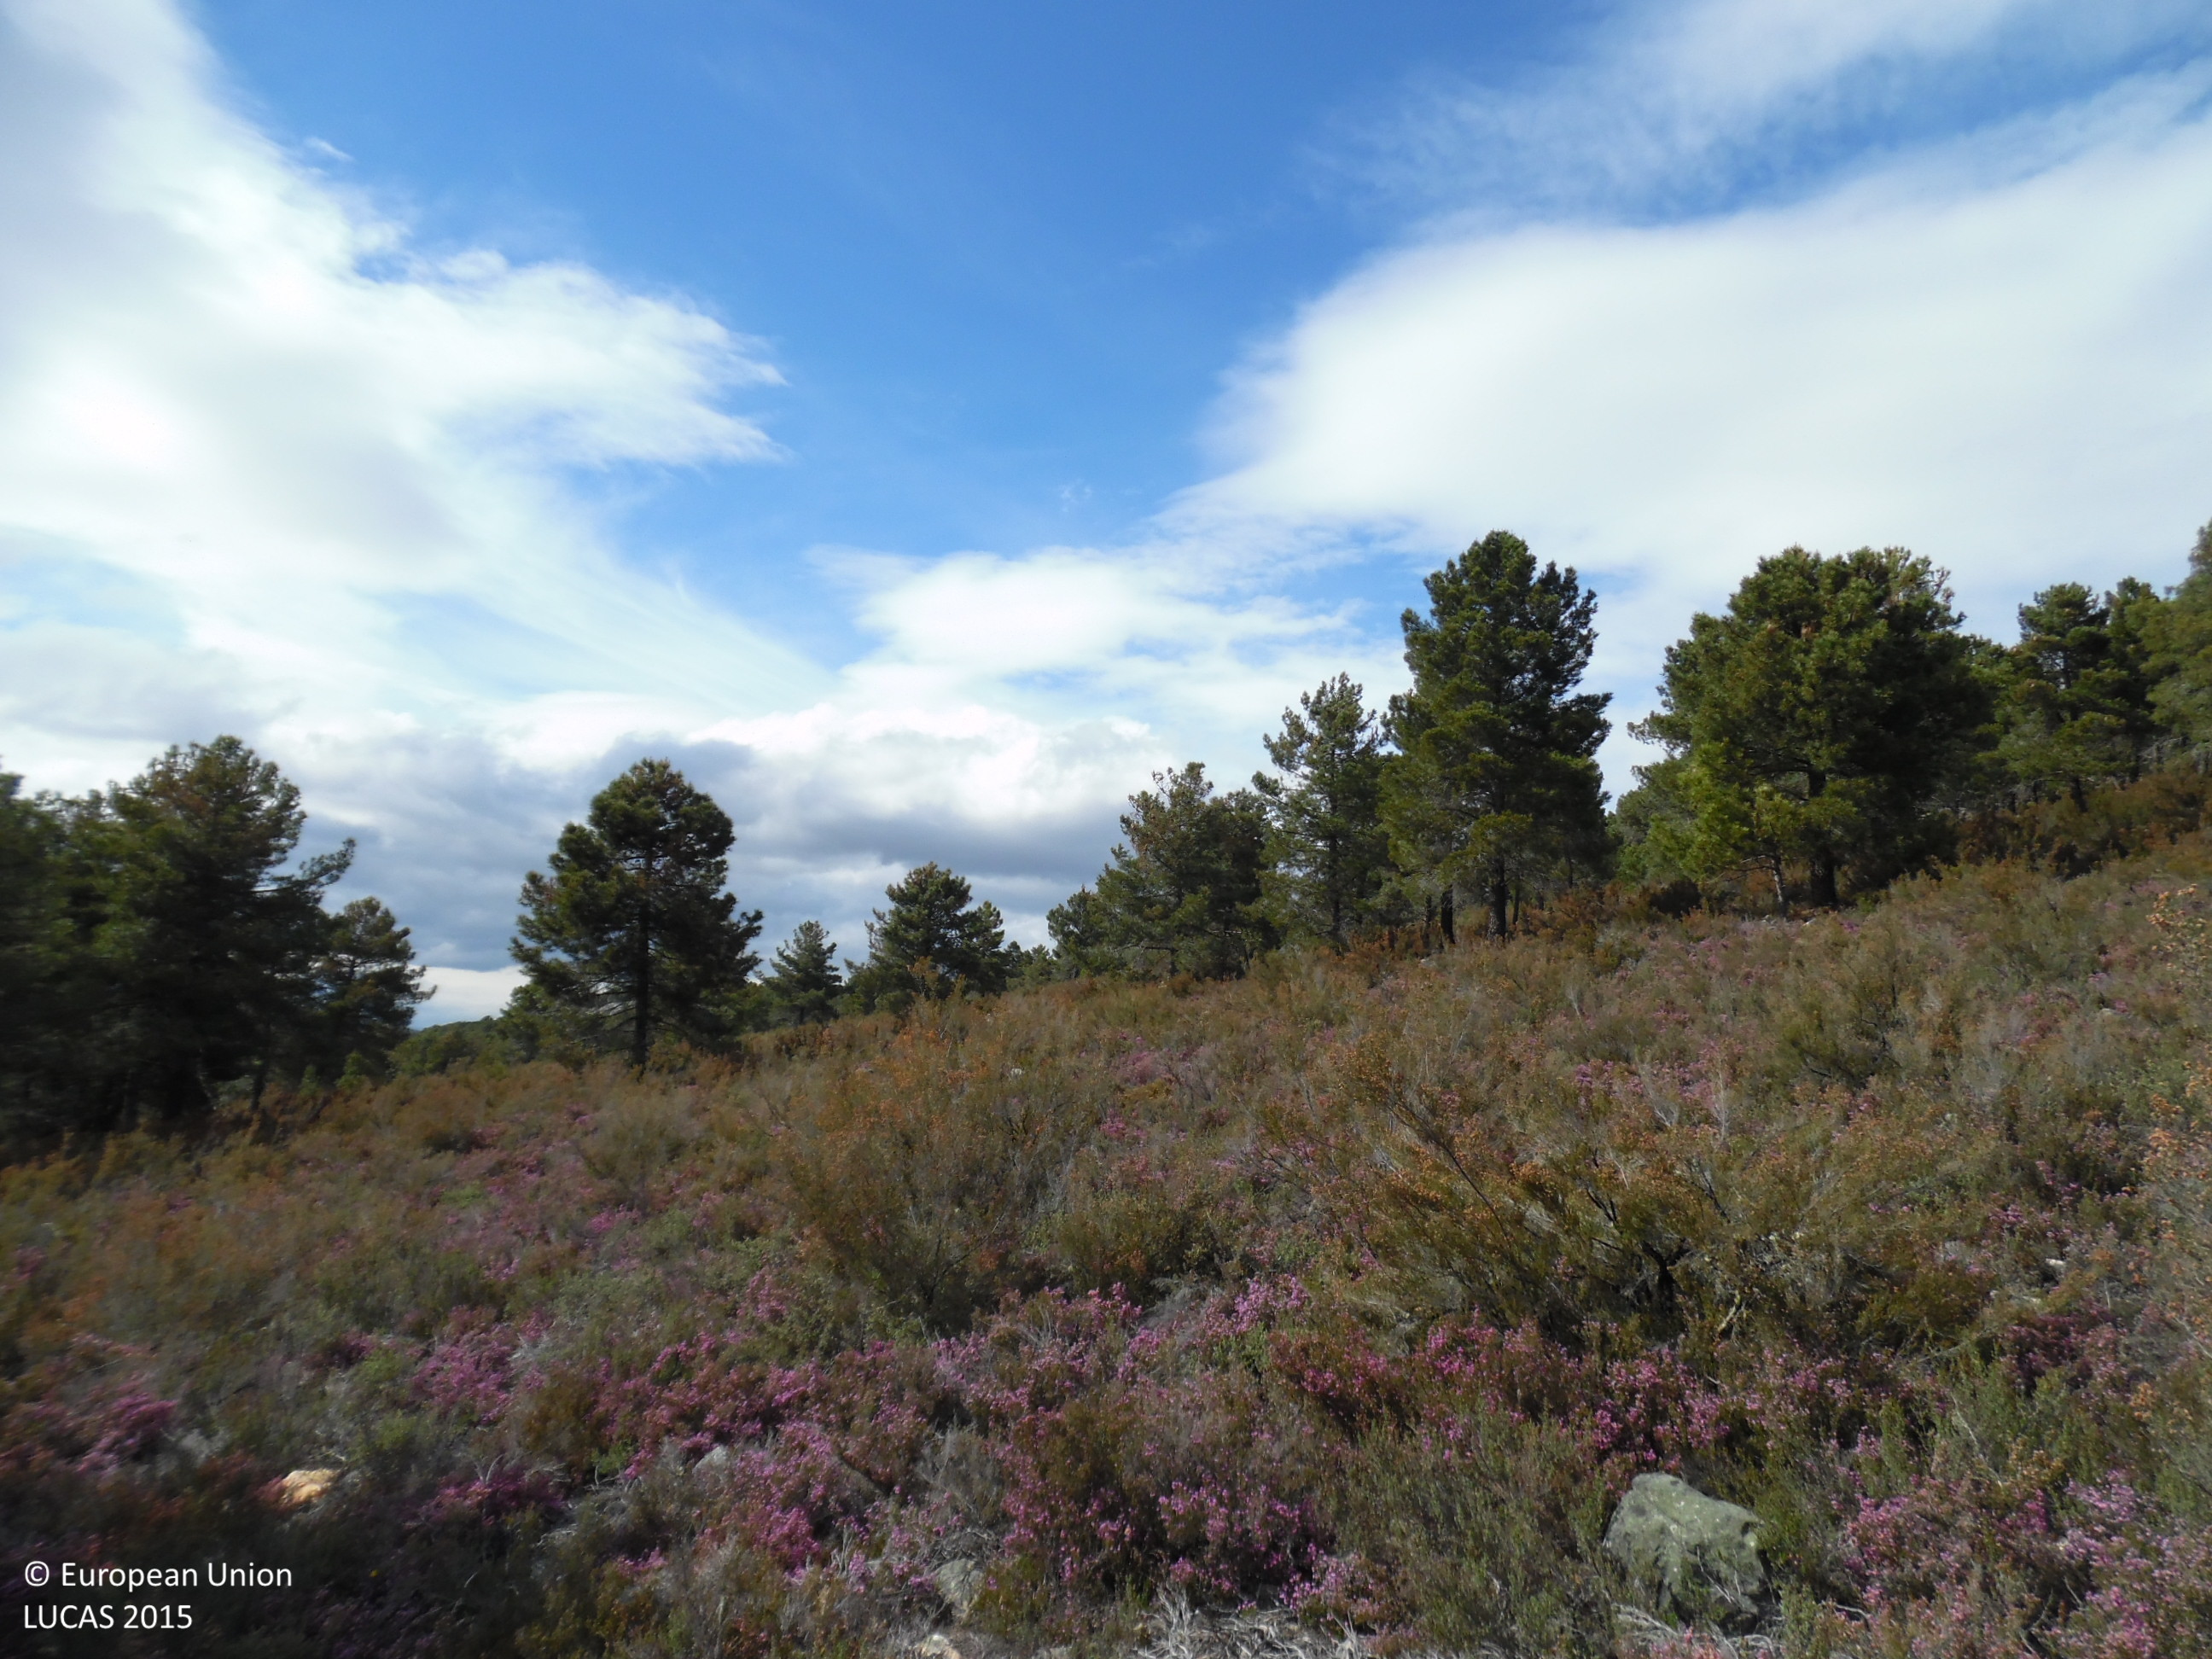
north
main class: Shrubland
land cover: Shrubland with sparse tree cover
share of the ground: > 75 %
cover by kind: shrubs 95 %, coniferous forest trees 5 %
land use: Forestry
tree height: > 5 m
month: April
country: ES
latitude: 42.1737
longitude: -6.0452
